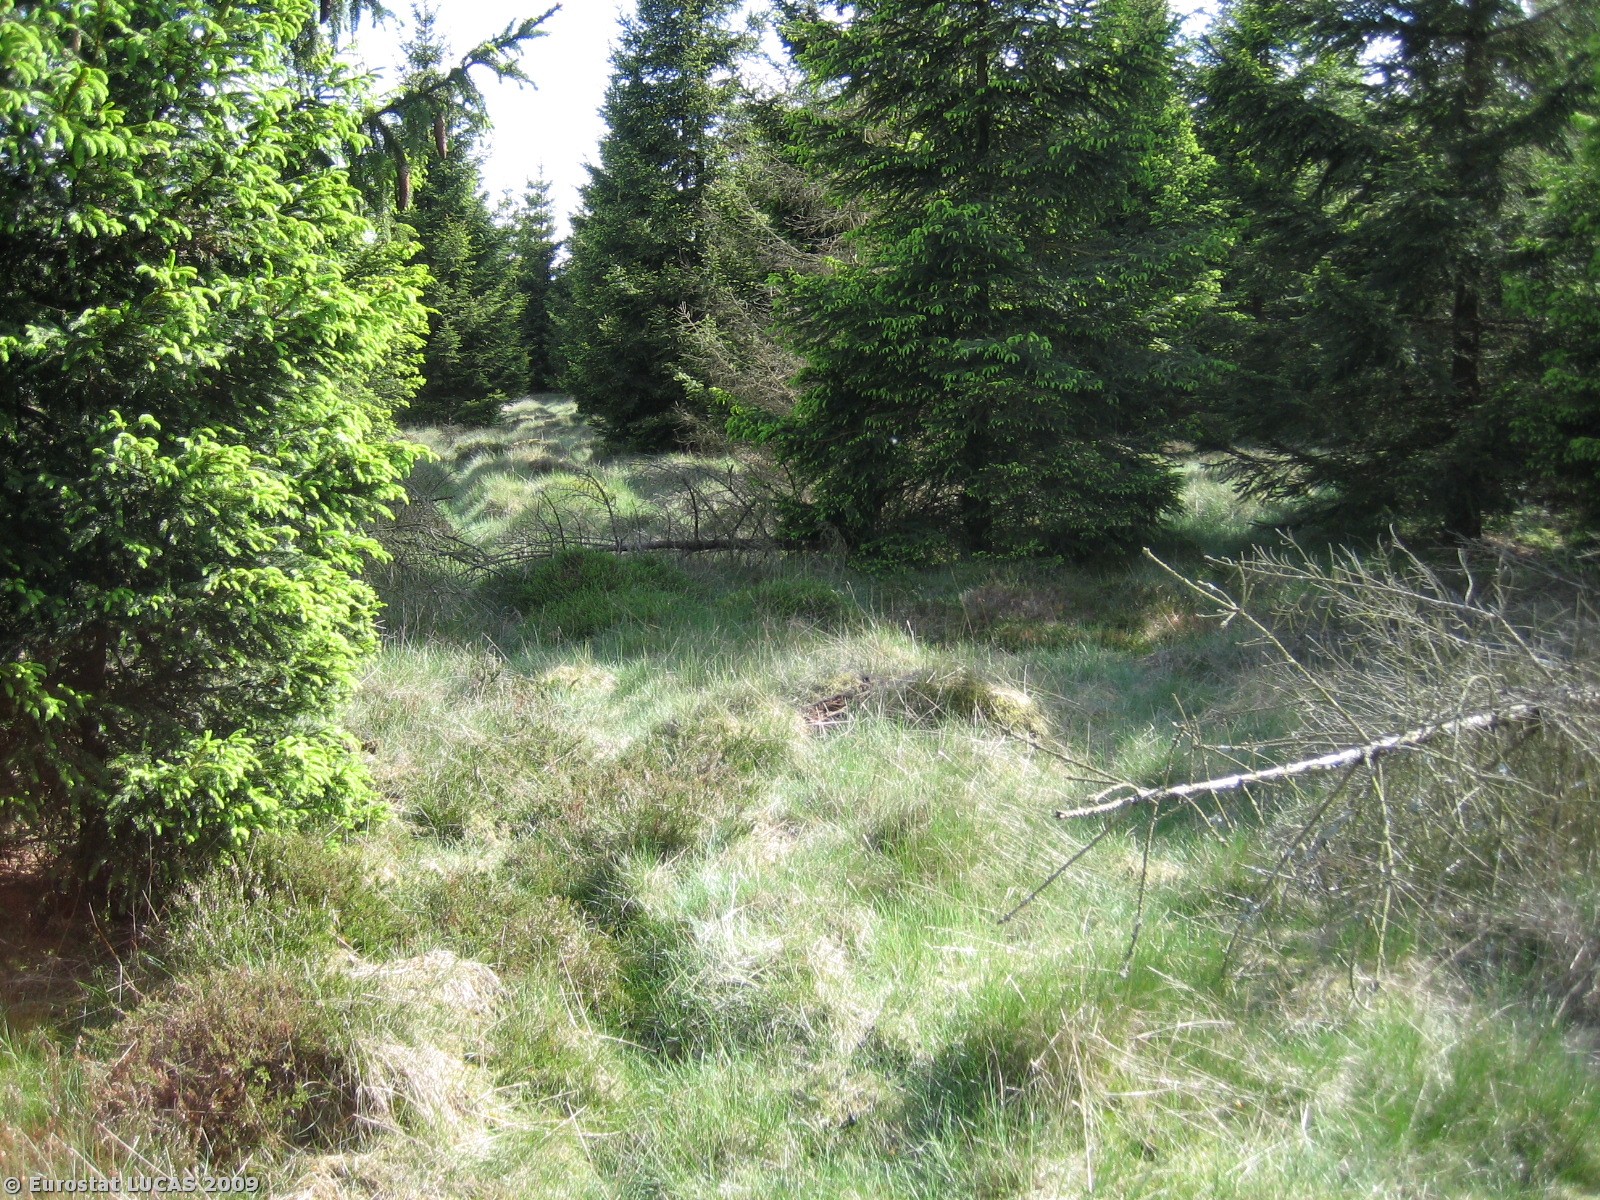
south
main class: Shrubland
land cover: Shrubland with sparse tree cover
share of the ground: > 75 %
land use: Forestry
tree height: > 5 m
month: May
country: DK
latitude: 56.0574
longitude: 8.9253
